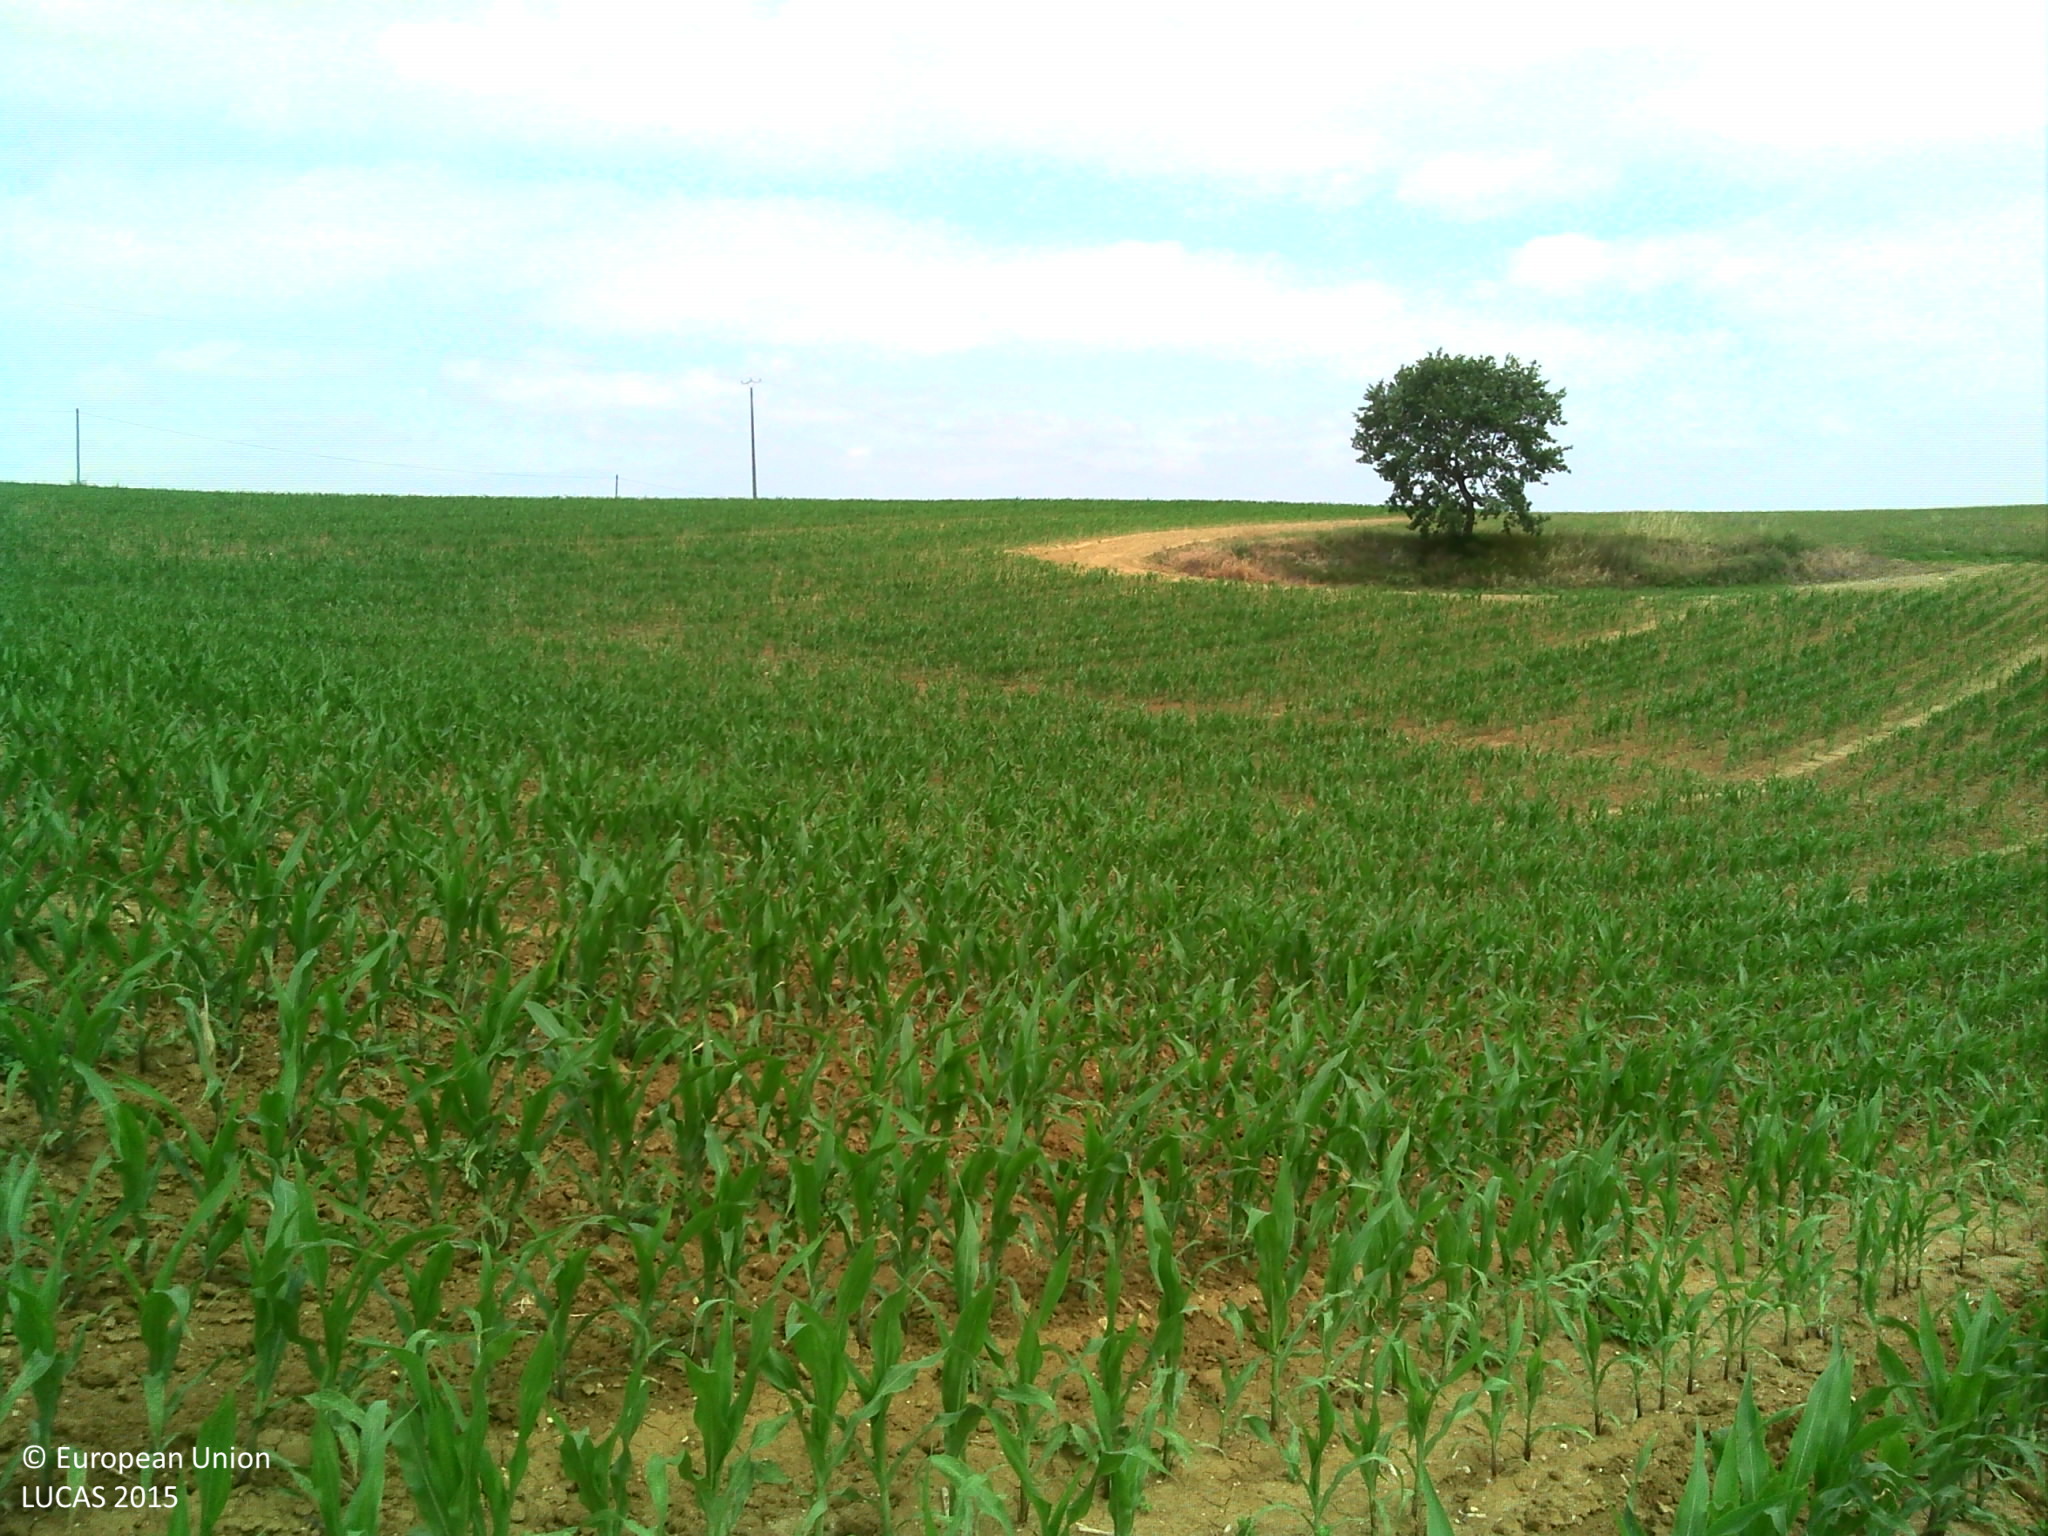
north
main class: Cropland
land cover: Maize
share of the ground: > 75 %
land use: Agriculture (excluding fallow land and kitchen gardens)
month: June
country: FR
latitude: 44.1323
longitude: 0.9103
